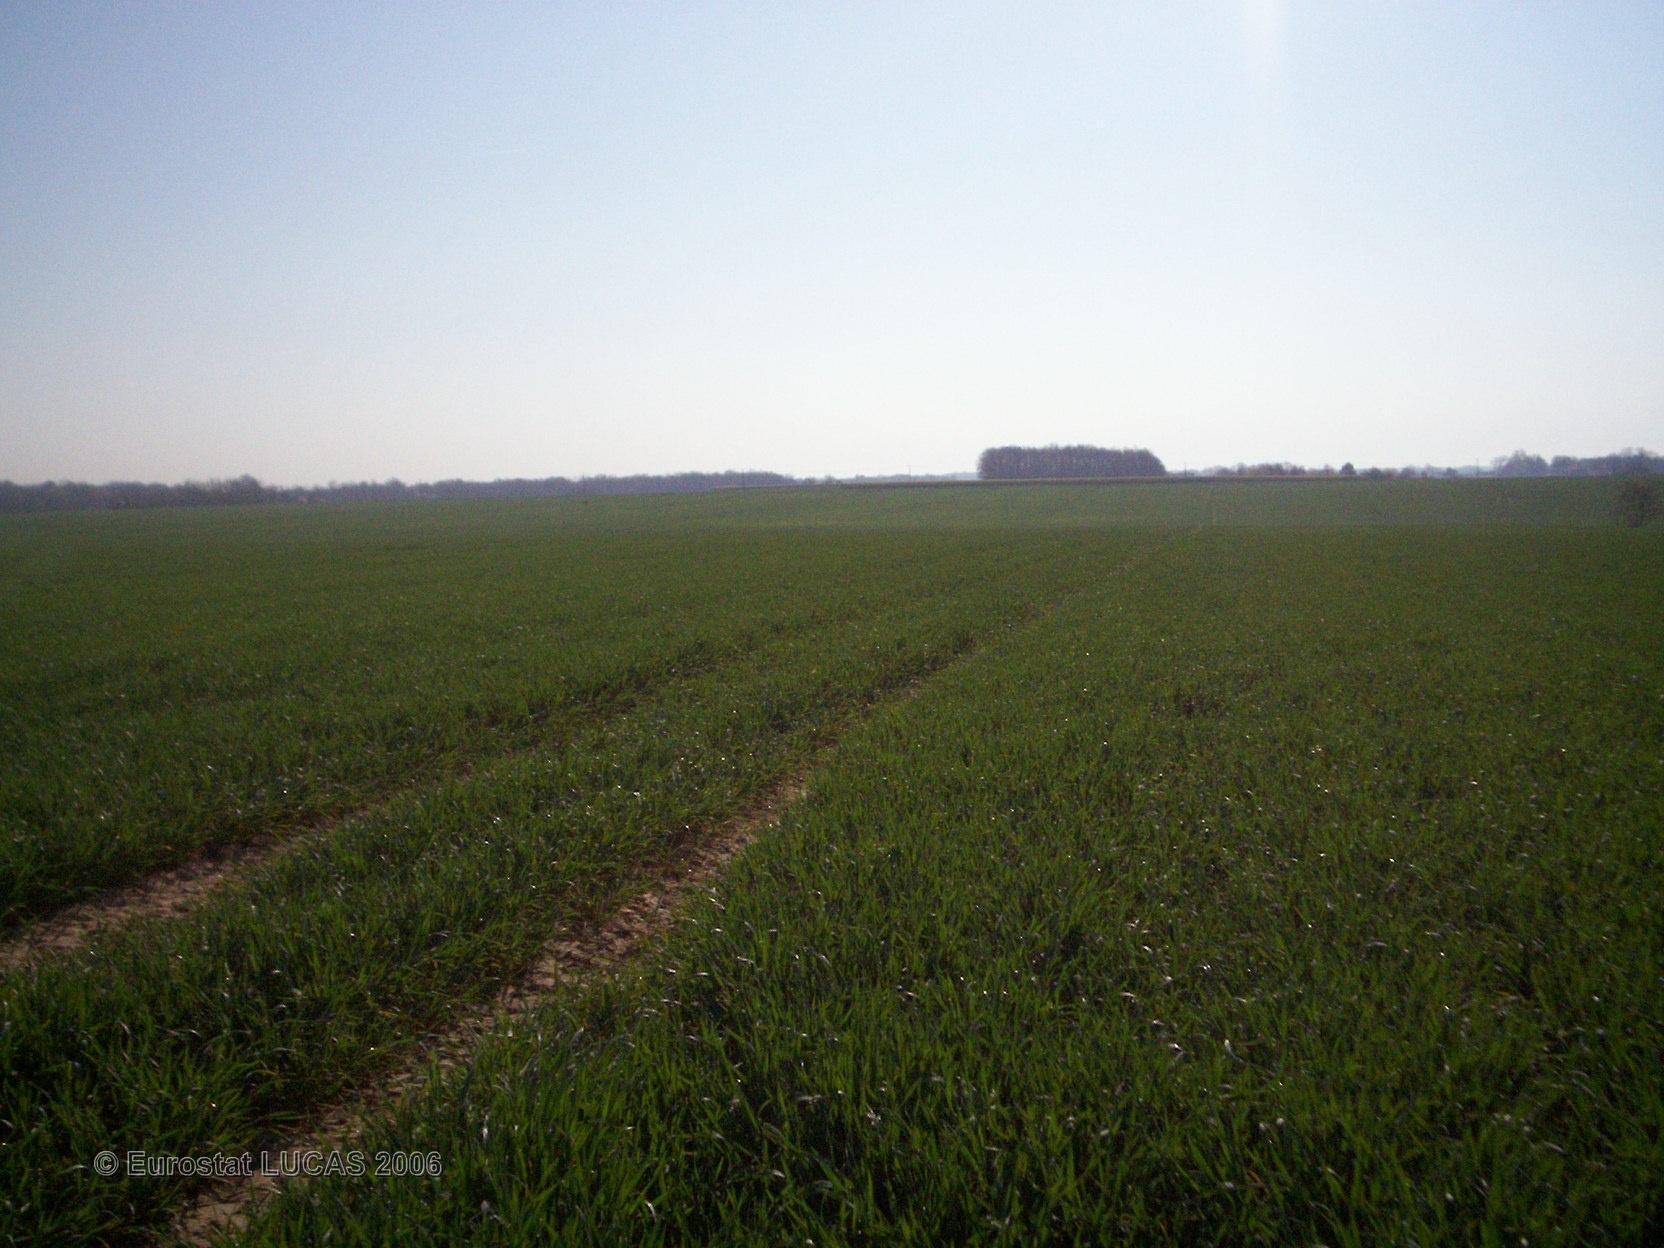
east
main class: Cropland
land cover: Common wheat
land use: Agriculture (excluding fallow land and kitchen gardens)
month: April
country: FR
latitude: 46.8701
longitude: 0.9188
